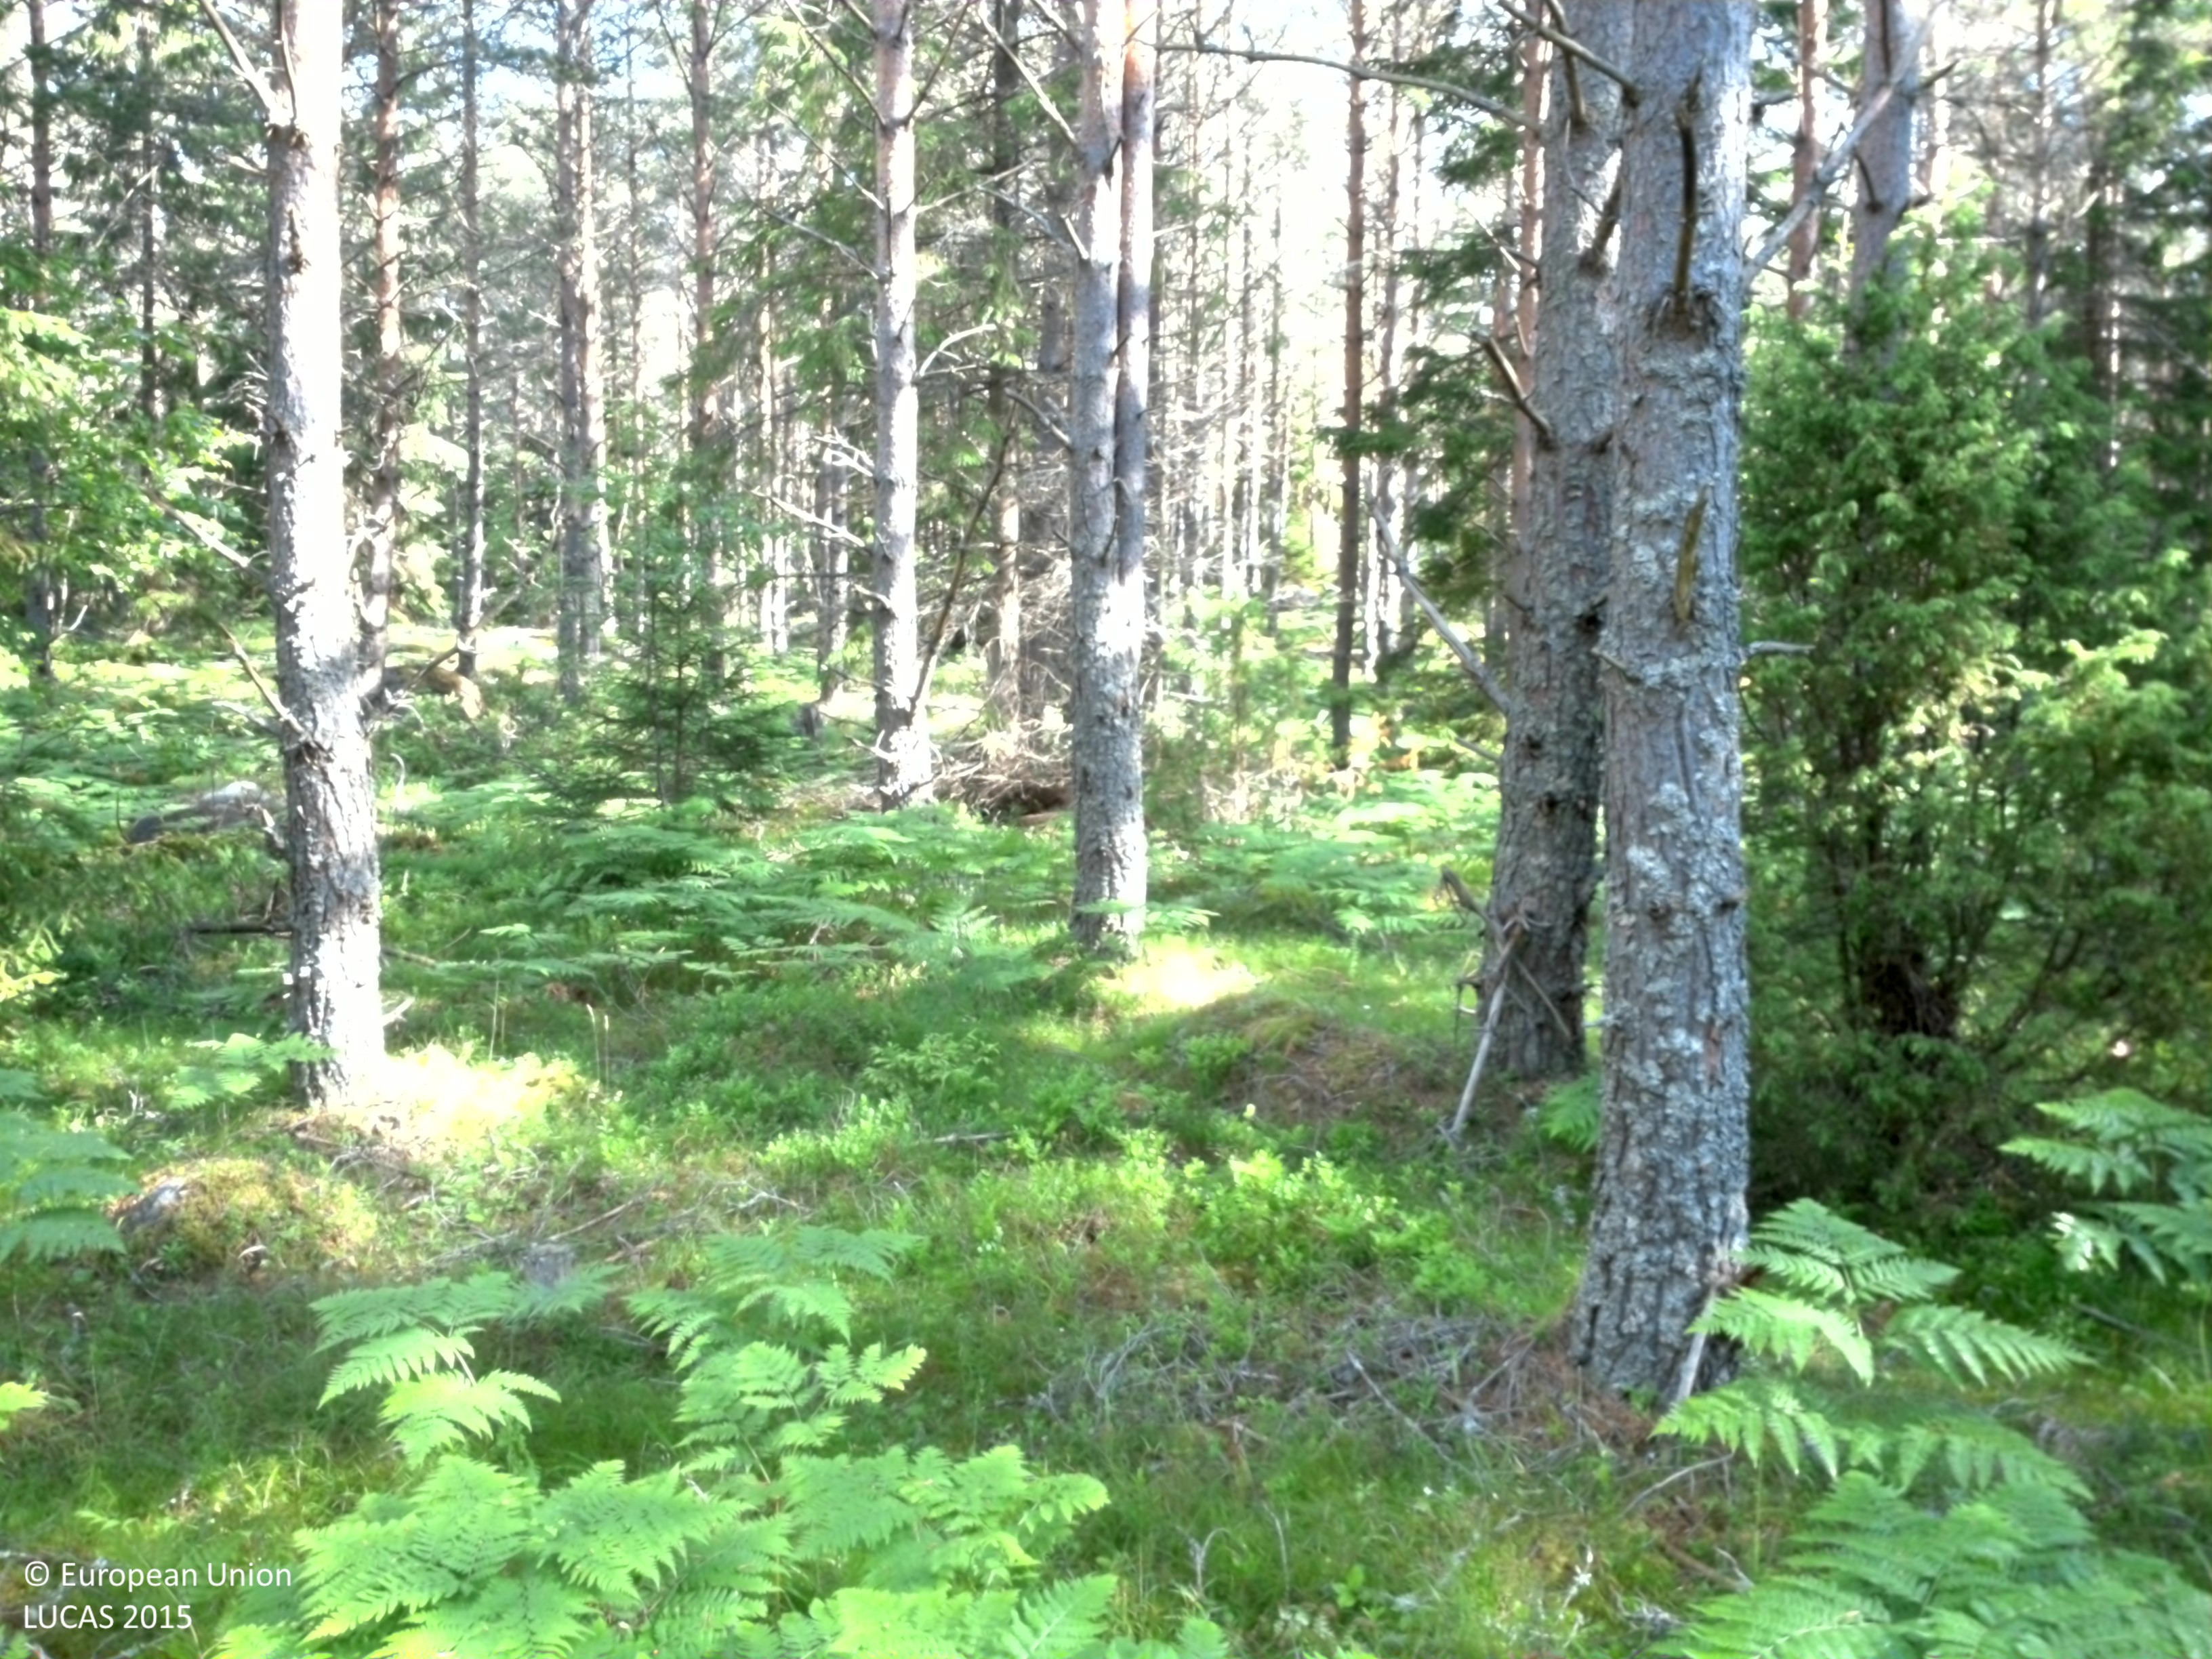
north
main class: Woodland
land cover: Pine dominated coniferous woodland
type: boreal forest
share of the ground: 25 - 50 %
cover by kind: herbaceous plants 55 %, coniferous forest trees 30 %, lichens and mosses 10 %, broadleaved forest trees 5 %
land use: Forestry
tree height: > 5 m
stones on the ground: 10 - 25 %
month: June
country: SE
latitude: 58.6126
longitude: 15.4852
